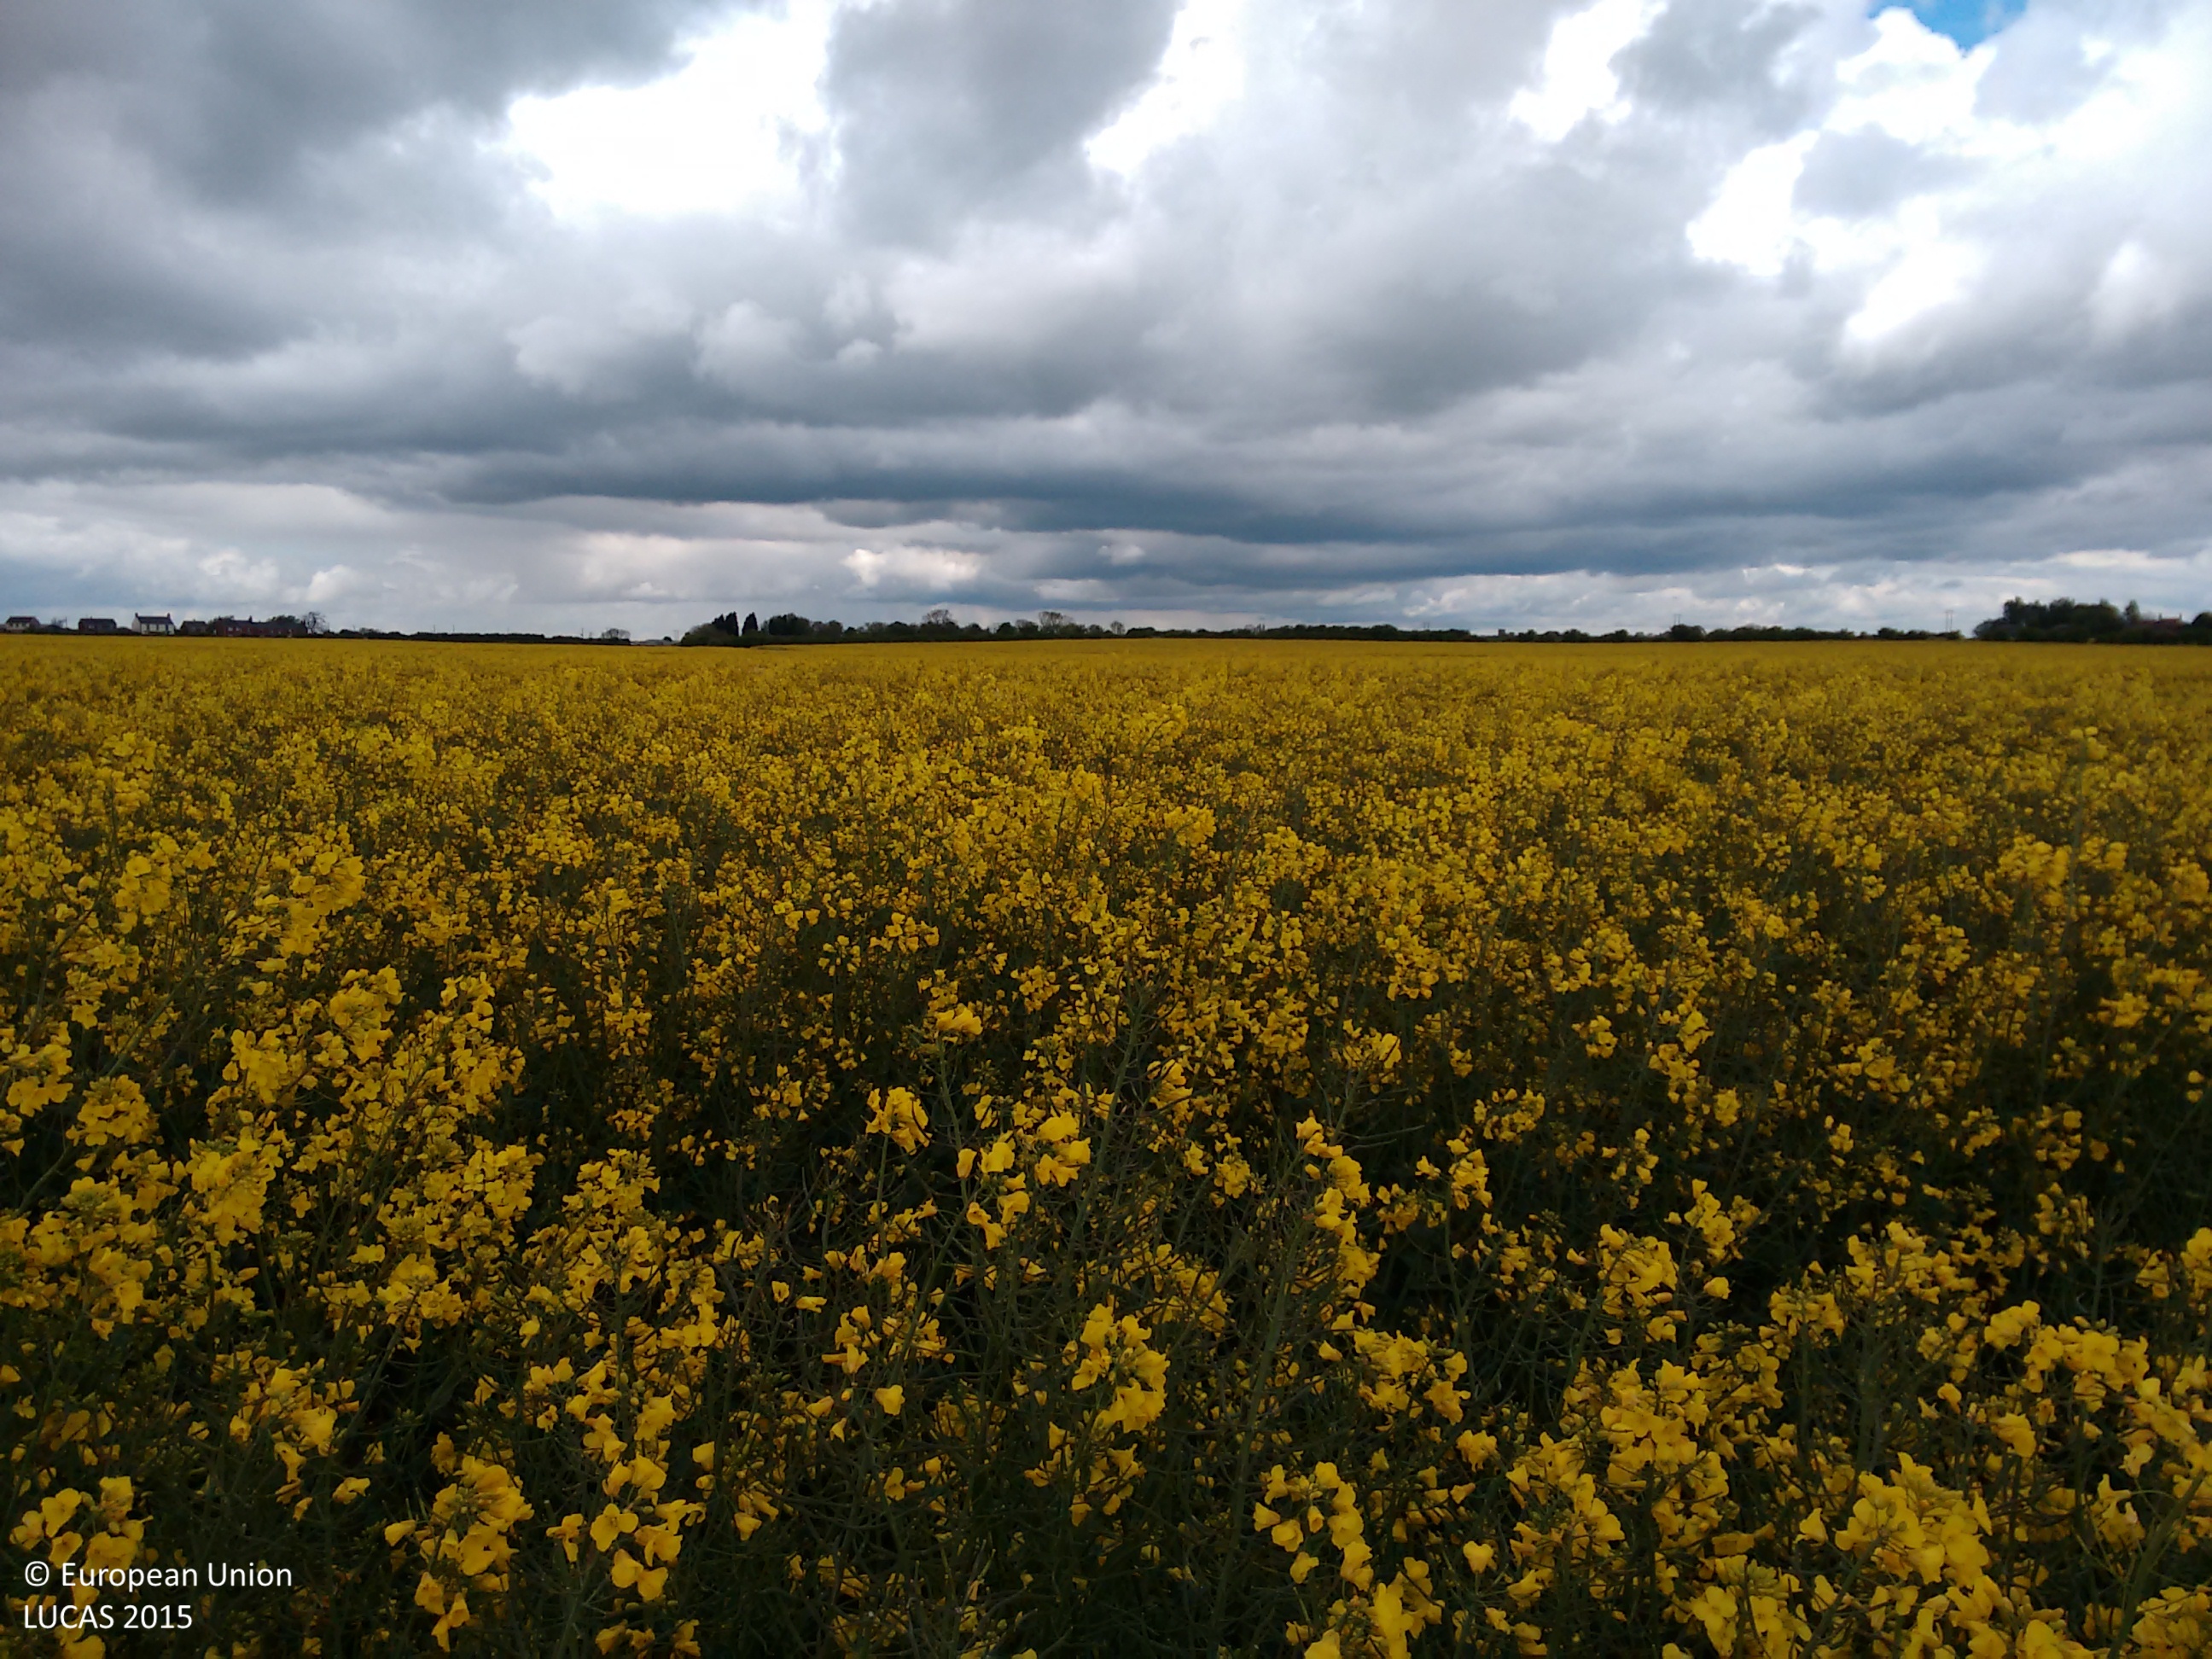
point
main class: Cropland
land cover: Rape and turnip rape
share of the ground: > 75 %
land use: Agriculture (excluding fallow land and kitchen gardens)
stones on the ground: < 10 %
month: May
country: GB
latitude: 53.7183
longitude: -0.1403
